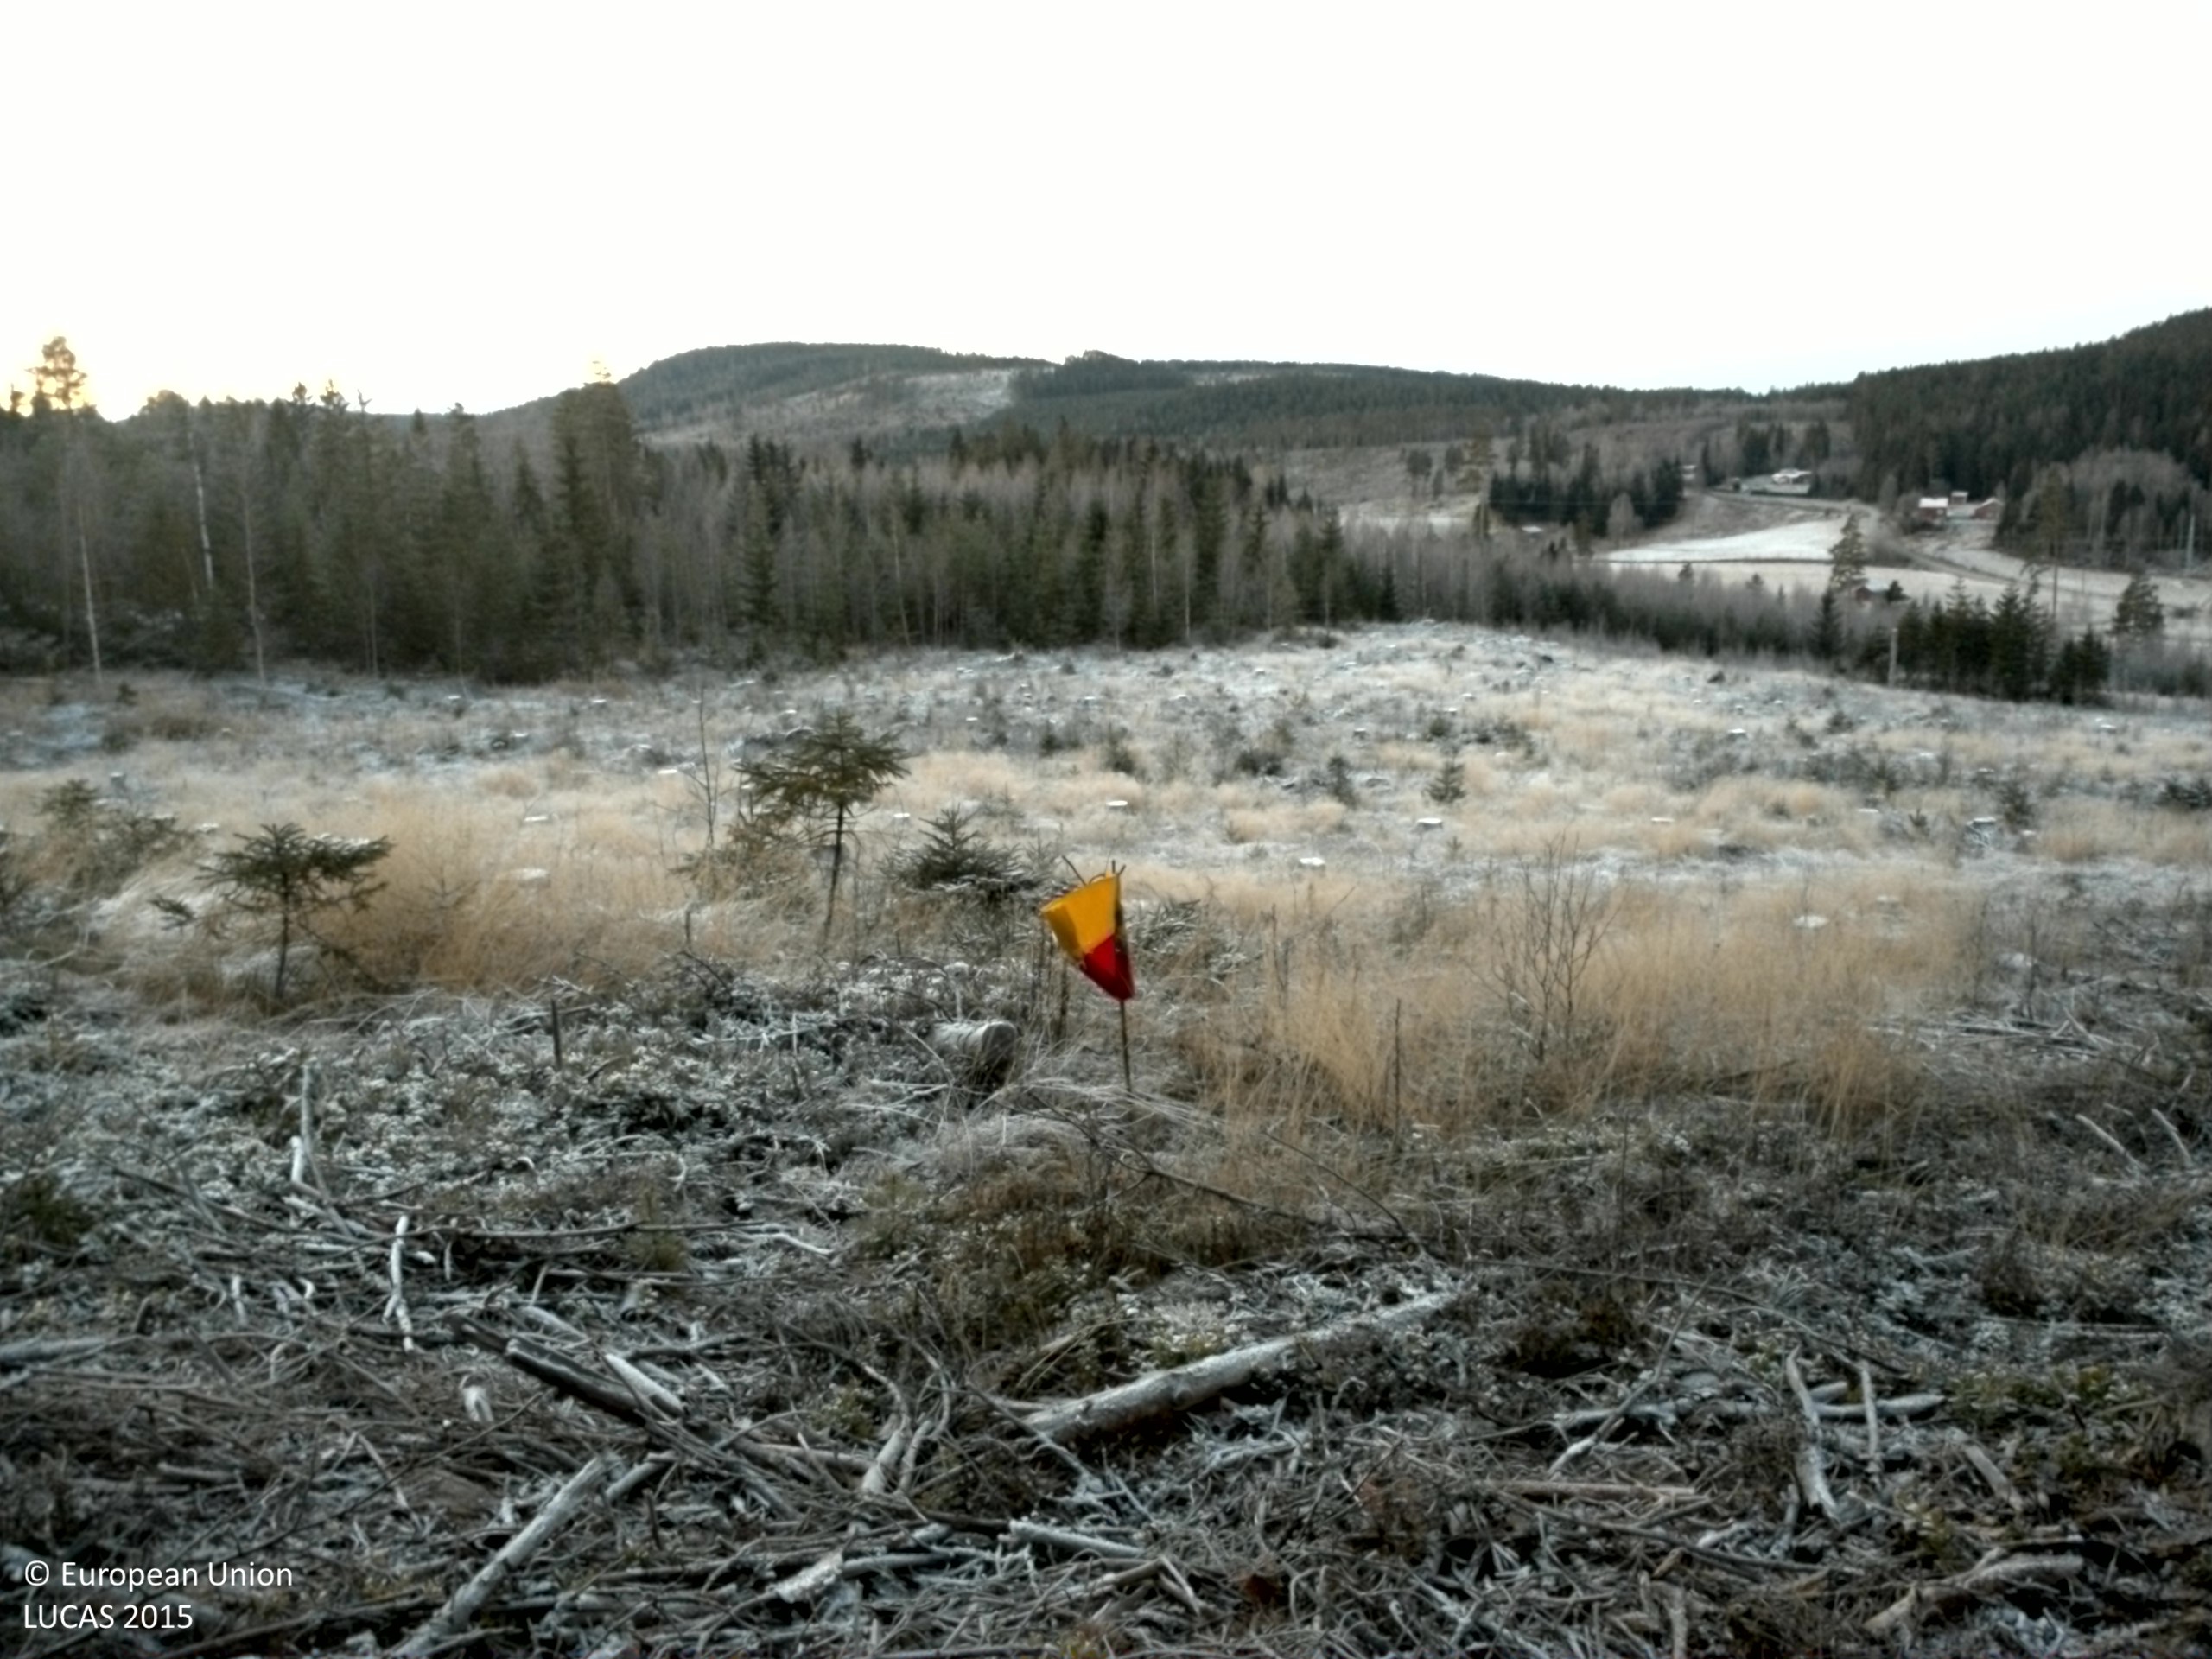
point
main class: Woodland
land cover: Other mixed woodland
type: boreal forest
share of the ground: 10 - 25 %
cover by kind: herbaceous plants 35 %, shrubs 25 %, lichens and mosses 25 %, coniferous forest trees 10 %, broadleaved forest trees 5 %
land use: Forestry
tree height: < 5 m
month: November
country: SE
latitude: 61.7394
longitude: 16.2873
